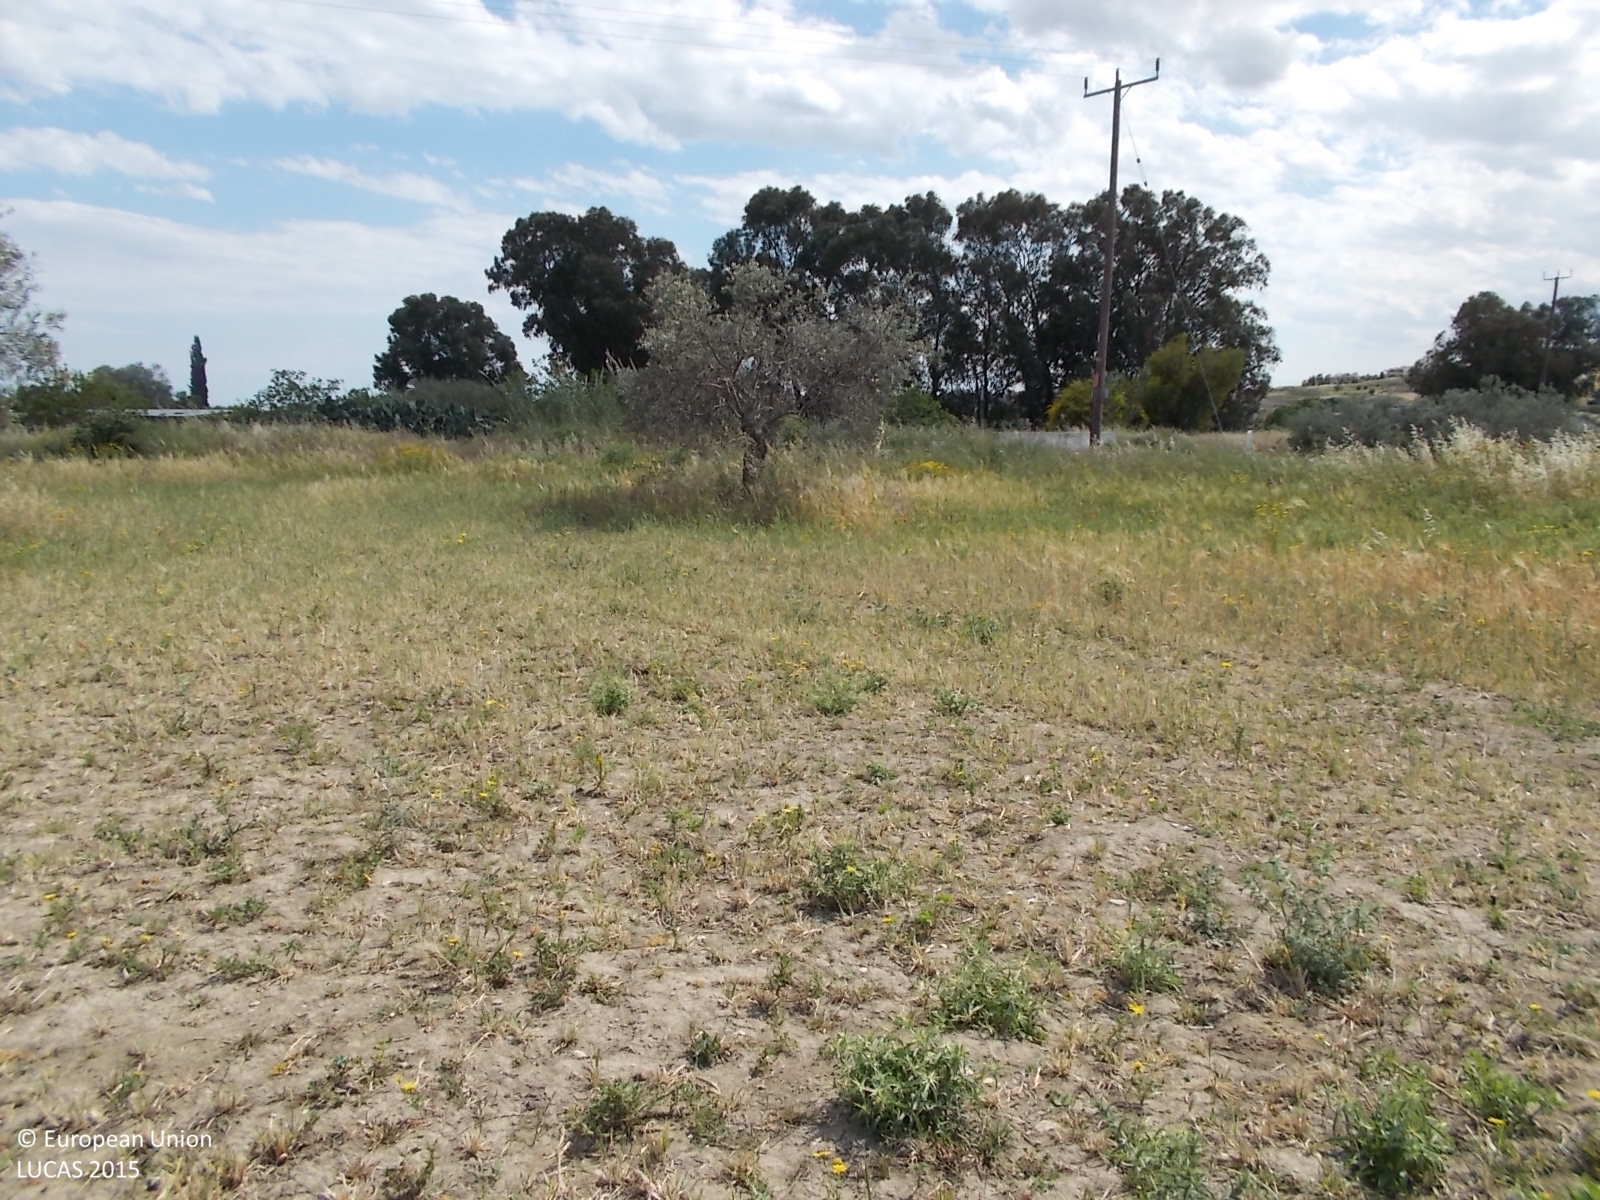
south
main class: Grassland
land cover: Grassland with sparse tree/shrub cover
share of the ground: 10 - 25 %
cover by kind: unconsolidated bare surface 80 %, herbaceous plants 15 %, broadleaved forest trees 5 %
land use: Agriculture (excluding fallow land and kitchen gardens)
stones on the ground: < 10 %
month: April
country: CY
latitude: 34.9986
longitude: 33.6585
